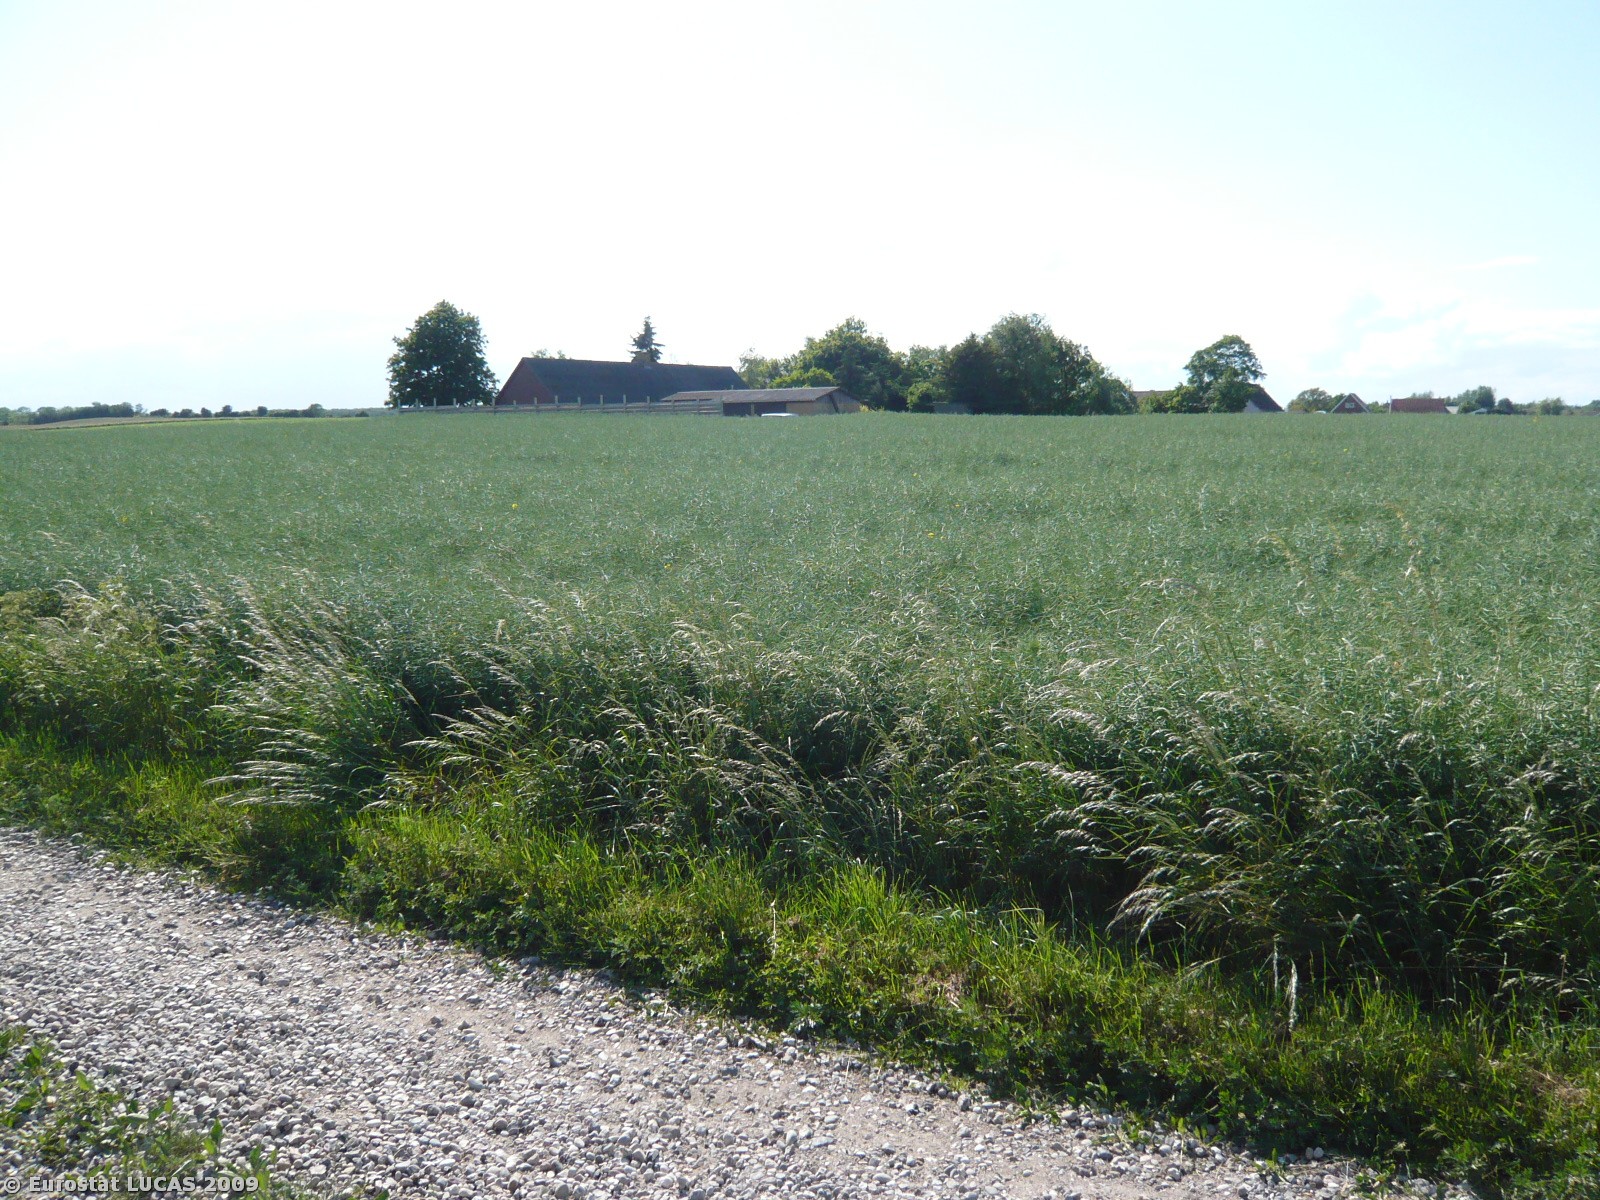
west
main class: Cropland
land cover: Rape and turnip rape
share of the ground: > 75 %
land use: Agriculture (excluding fallow land and kitchen gardens)
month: June
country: DK
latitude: 55.3191
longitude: 11.2124
